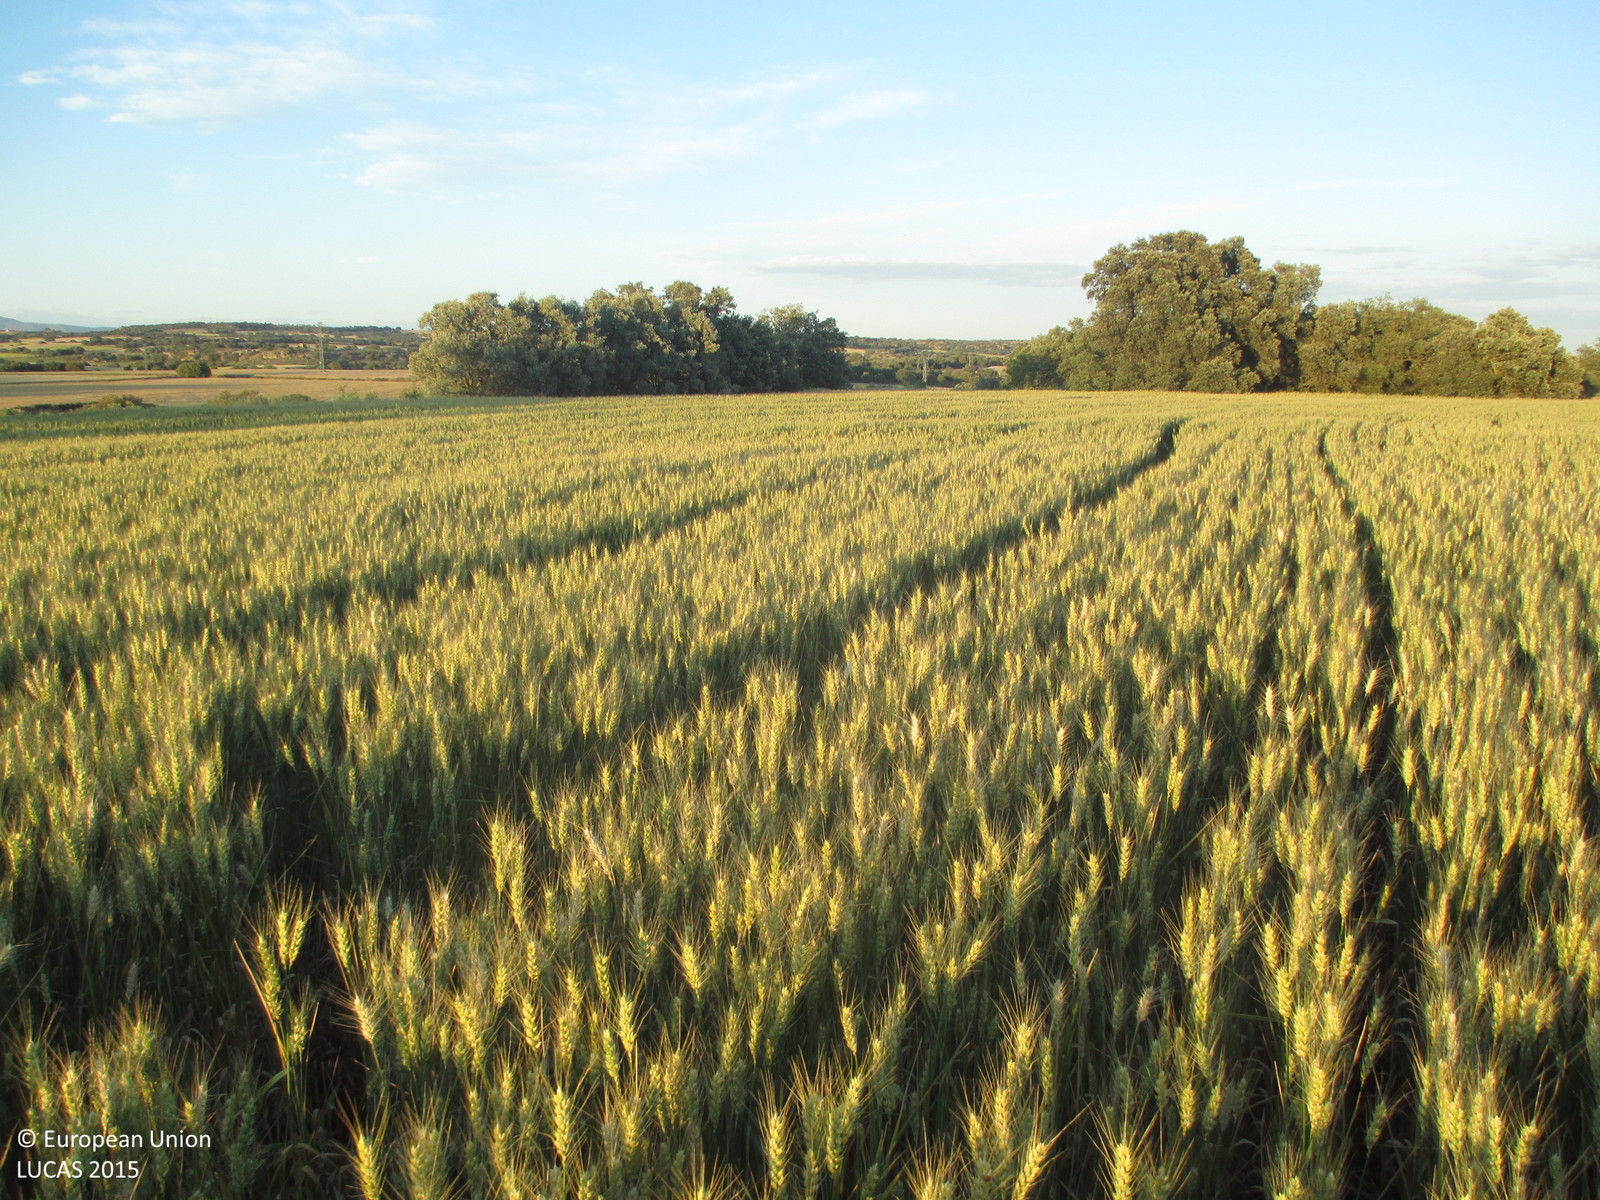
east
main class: Cropland
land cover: Common wheat
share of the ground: > 75 %
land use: Agriculture (excluding fallow land and kitchen gardens)
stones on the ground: < 10 %
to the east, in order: Common wheat; Shrubland with sparse tree cover; Common wheat; Shrubland with sparse tree cover; Tracks; Broadleaved woodland; Barley; Grass margins; Barley
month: May
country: ES
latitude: 42.0666
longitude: -0.1843
